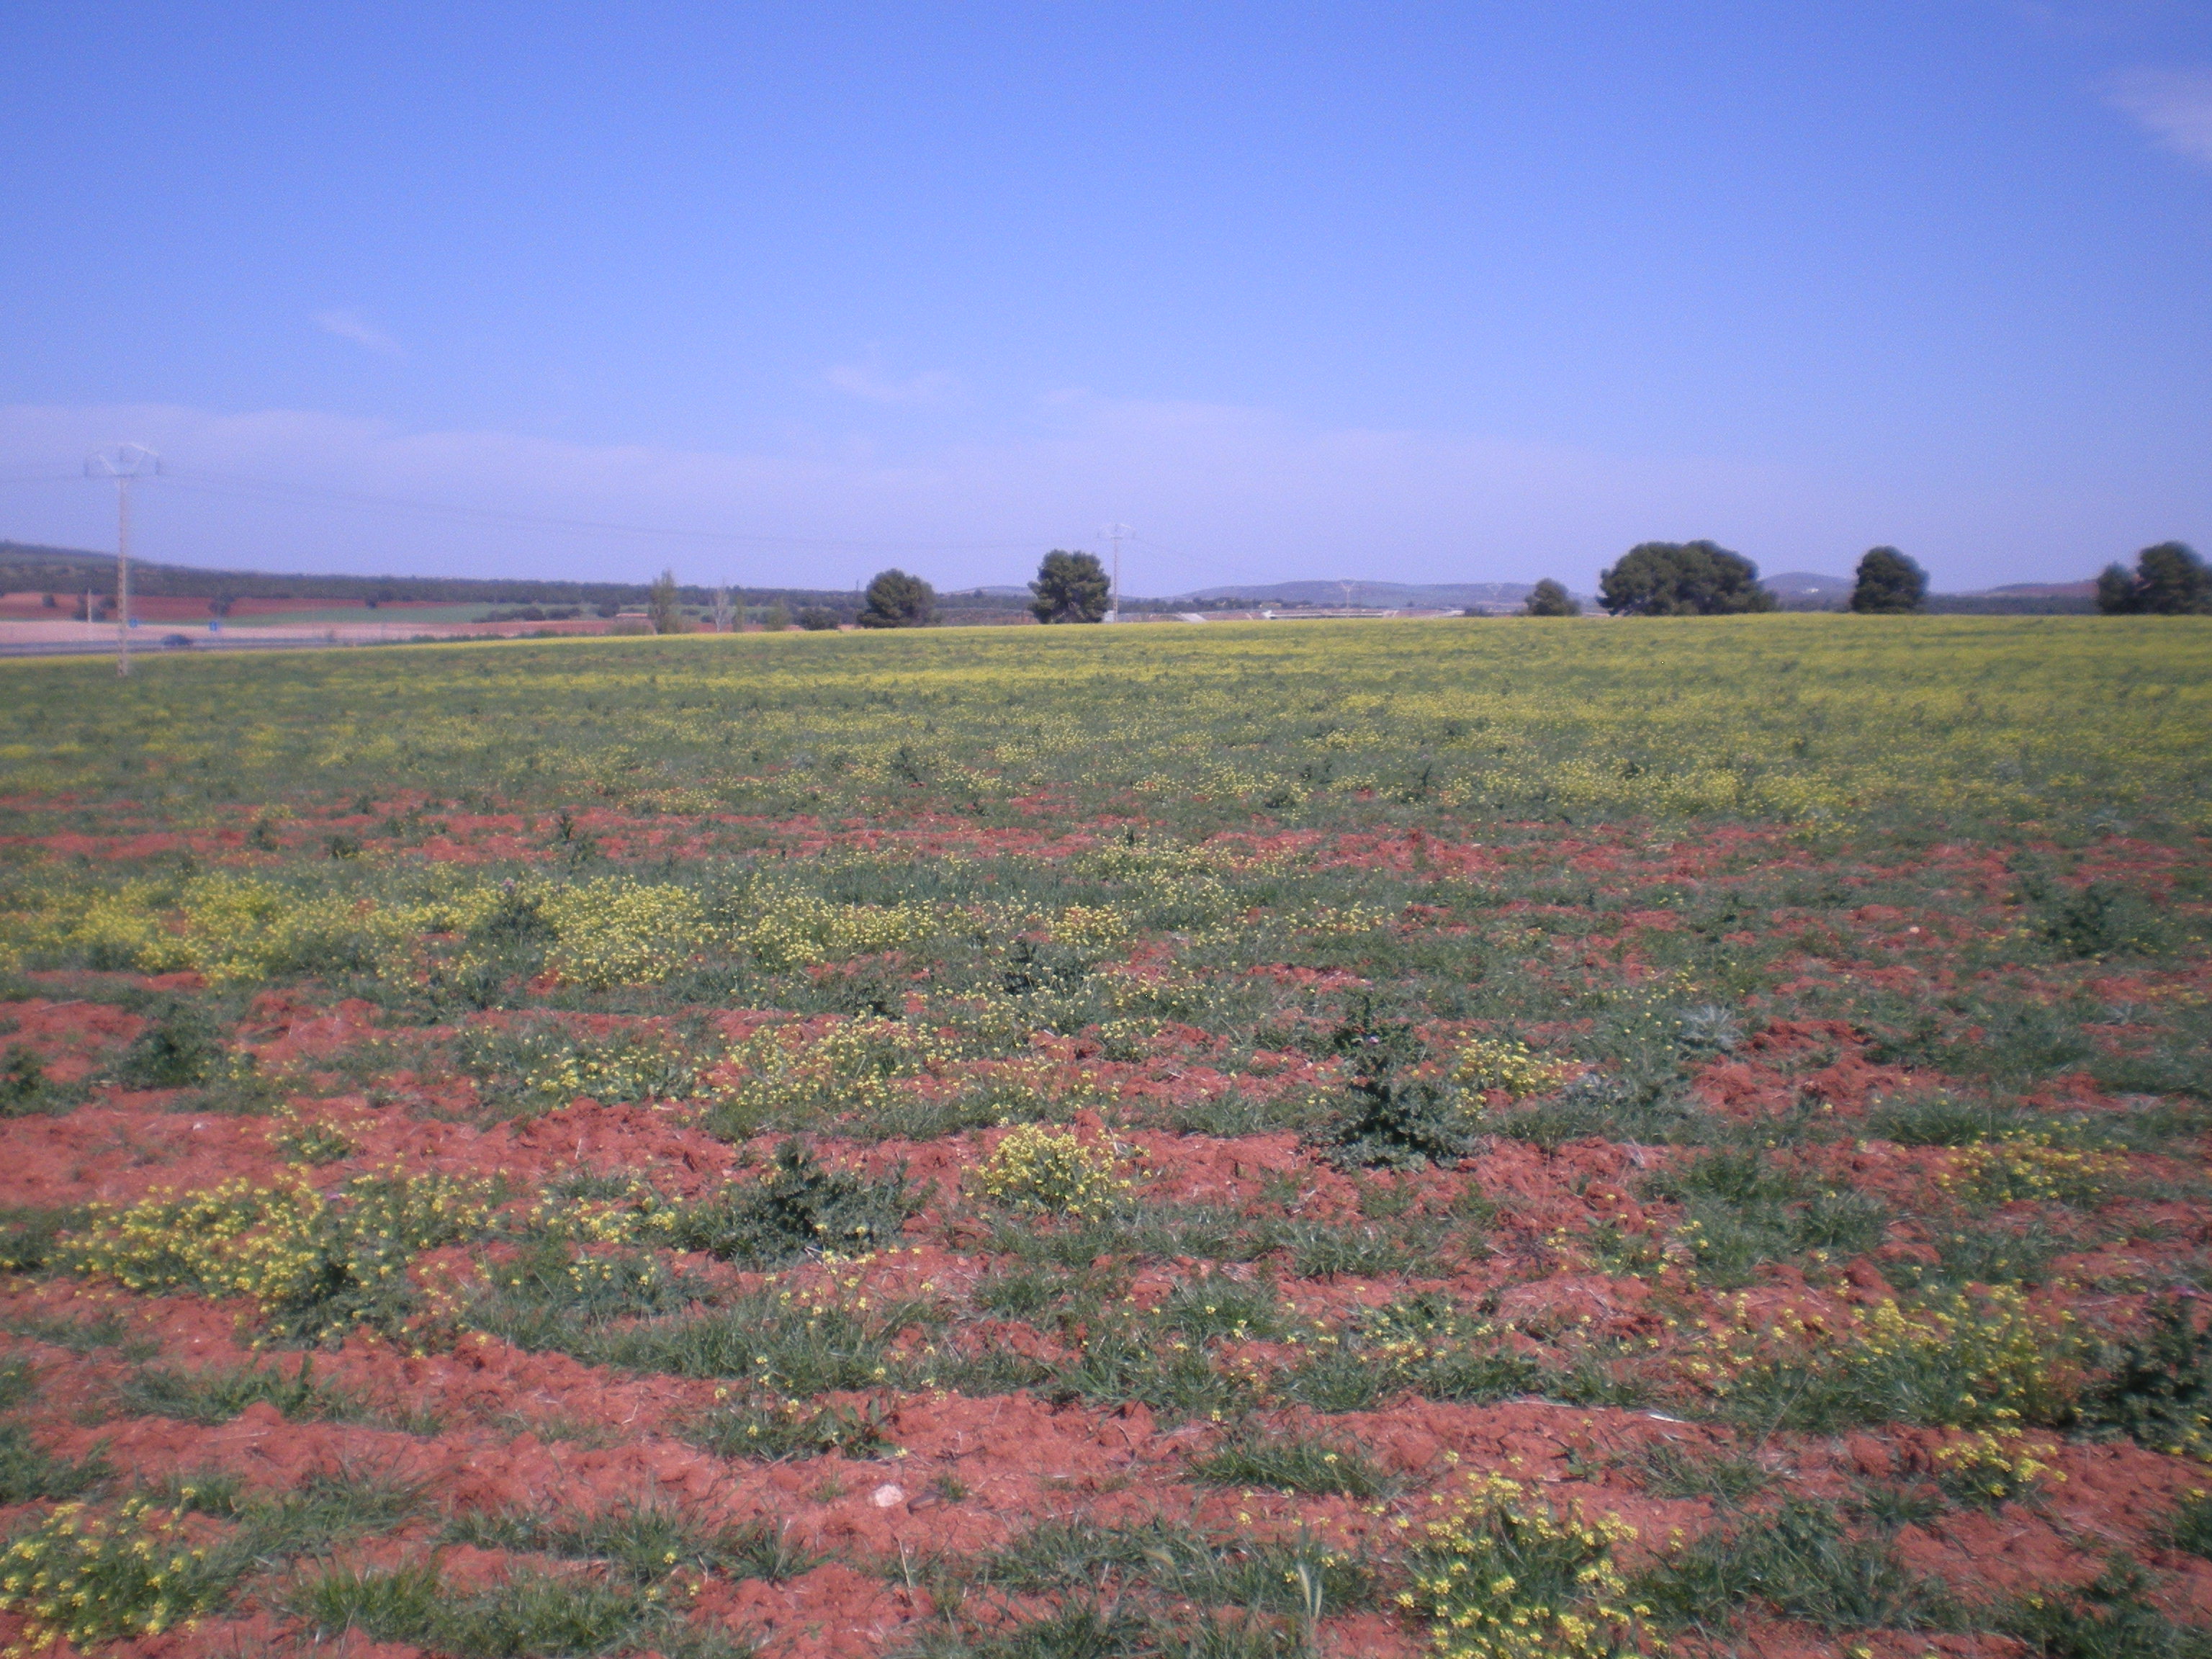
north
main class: Grassland
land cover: Spontaneously vegetated surfaces
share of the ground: > 75 %
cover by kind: unconsolidated bare surface 60 %, herbaceous plants 40 %
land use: Agriculture (excluding fallow land and kitchen gardens)
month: April
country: ES
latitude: 38.5429
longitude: -3.4900
